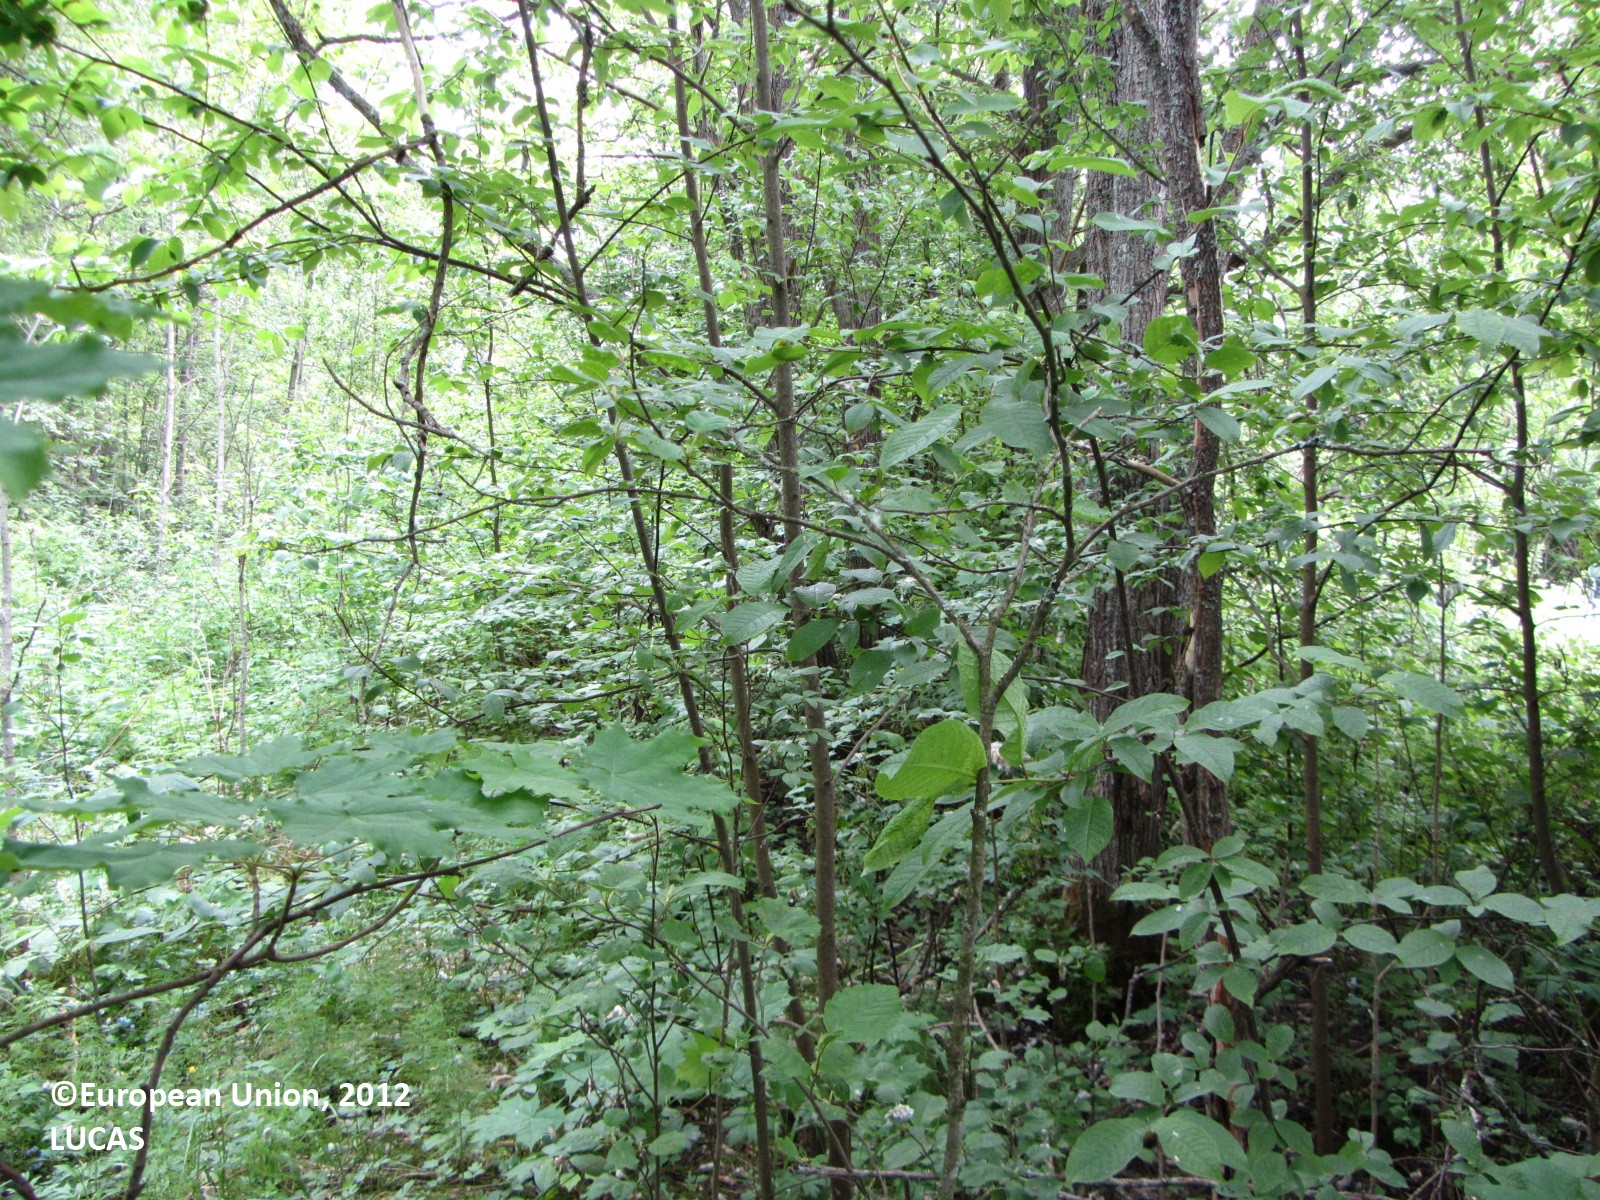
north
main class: Woodland
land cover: Broadleaved woodland
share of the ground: 50 - 75 %
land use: Semi-natural and natural areas not in use
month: June
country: FI
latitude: 61.8583
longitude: 25.1429
